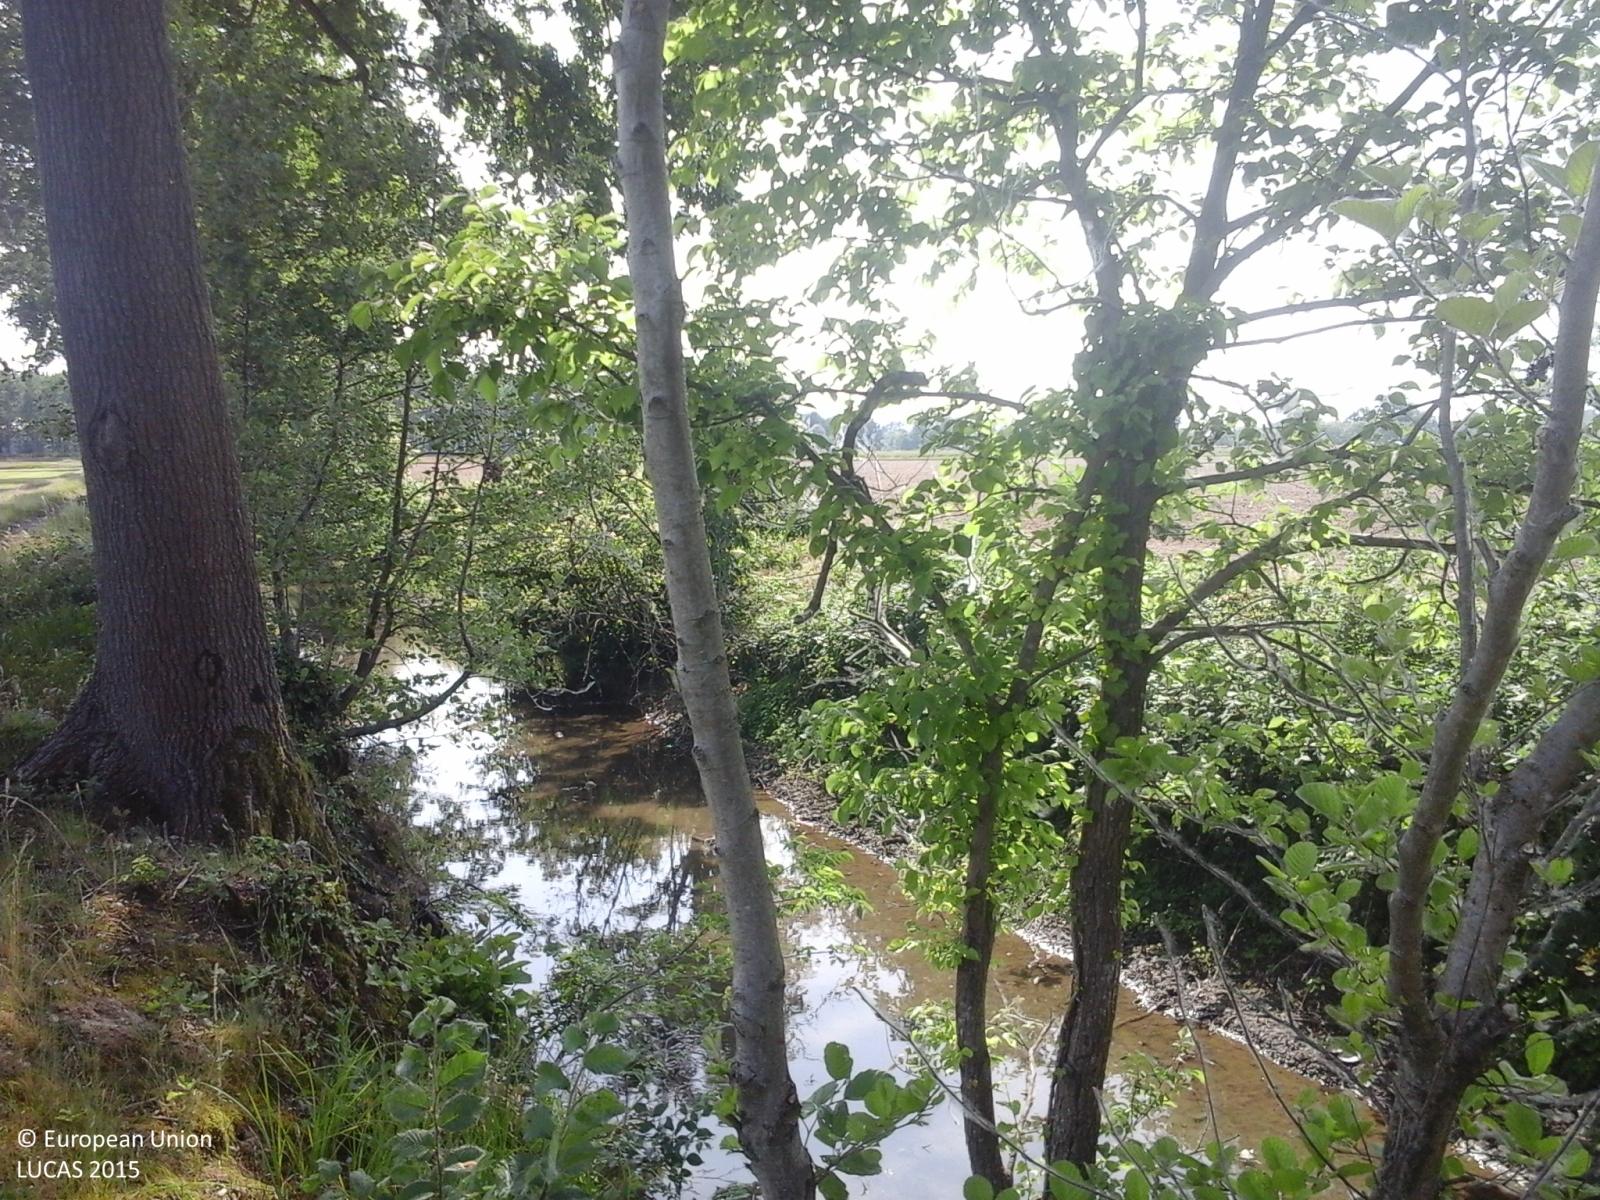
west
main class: Cropland
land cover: Rice
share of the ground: > 75 %
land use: Agriculture (excluding fallow land and kitchen gardens)
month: May
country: IT
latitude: 45.3389
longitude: 9.1720
